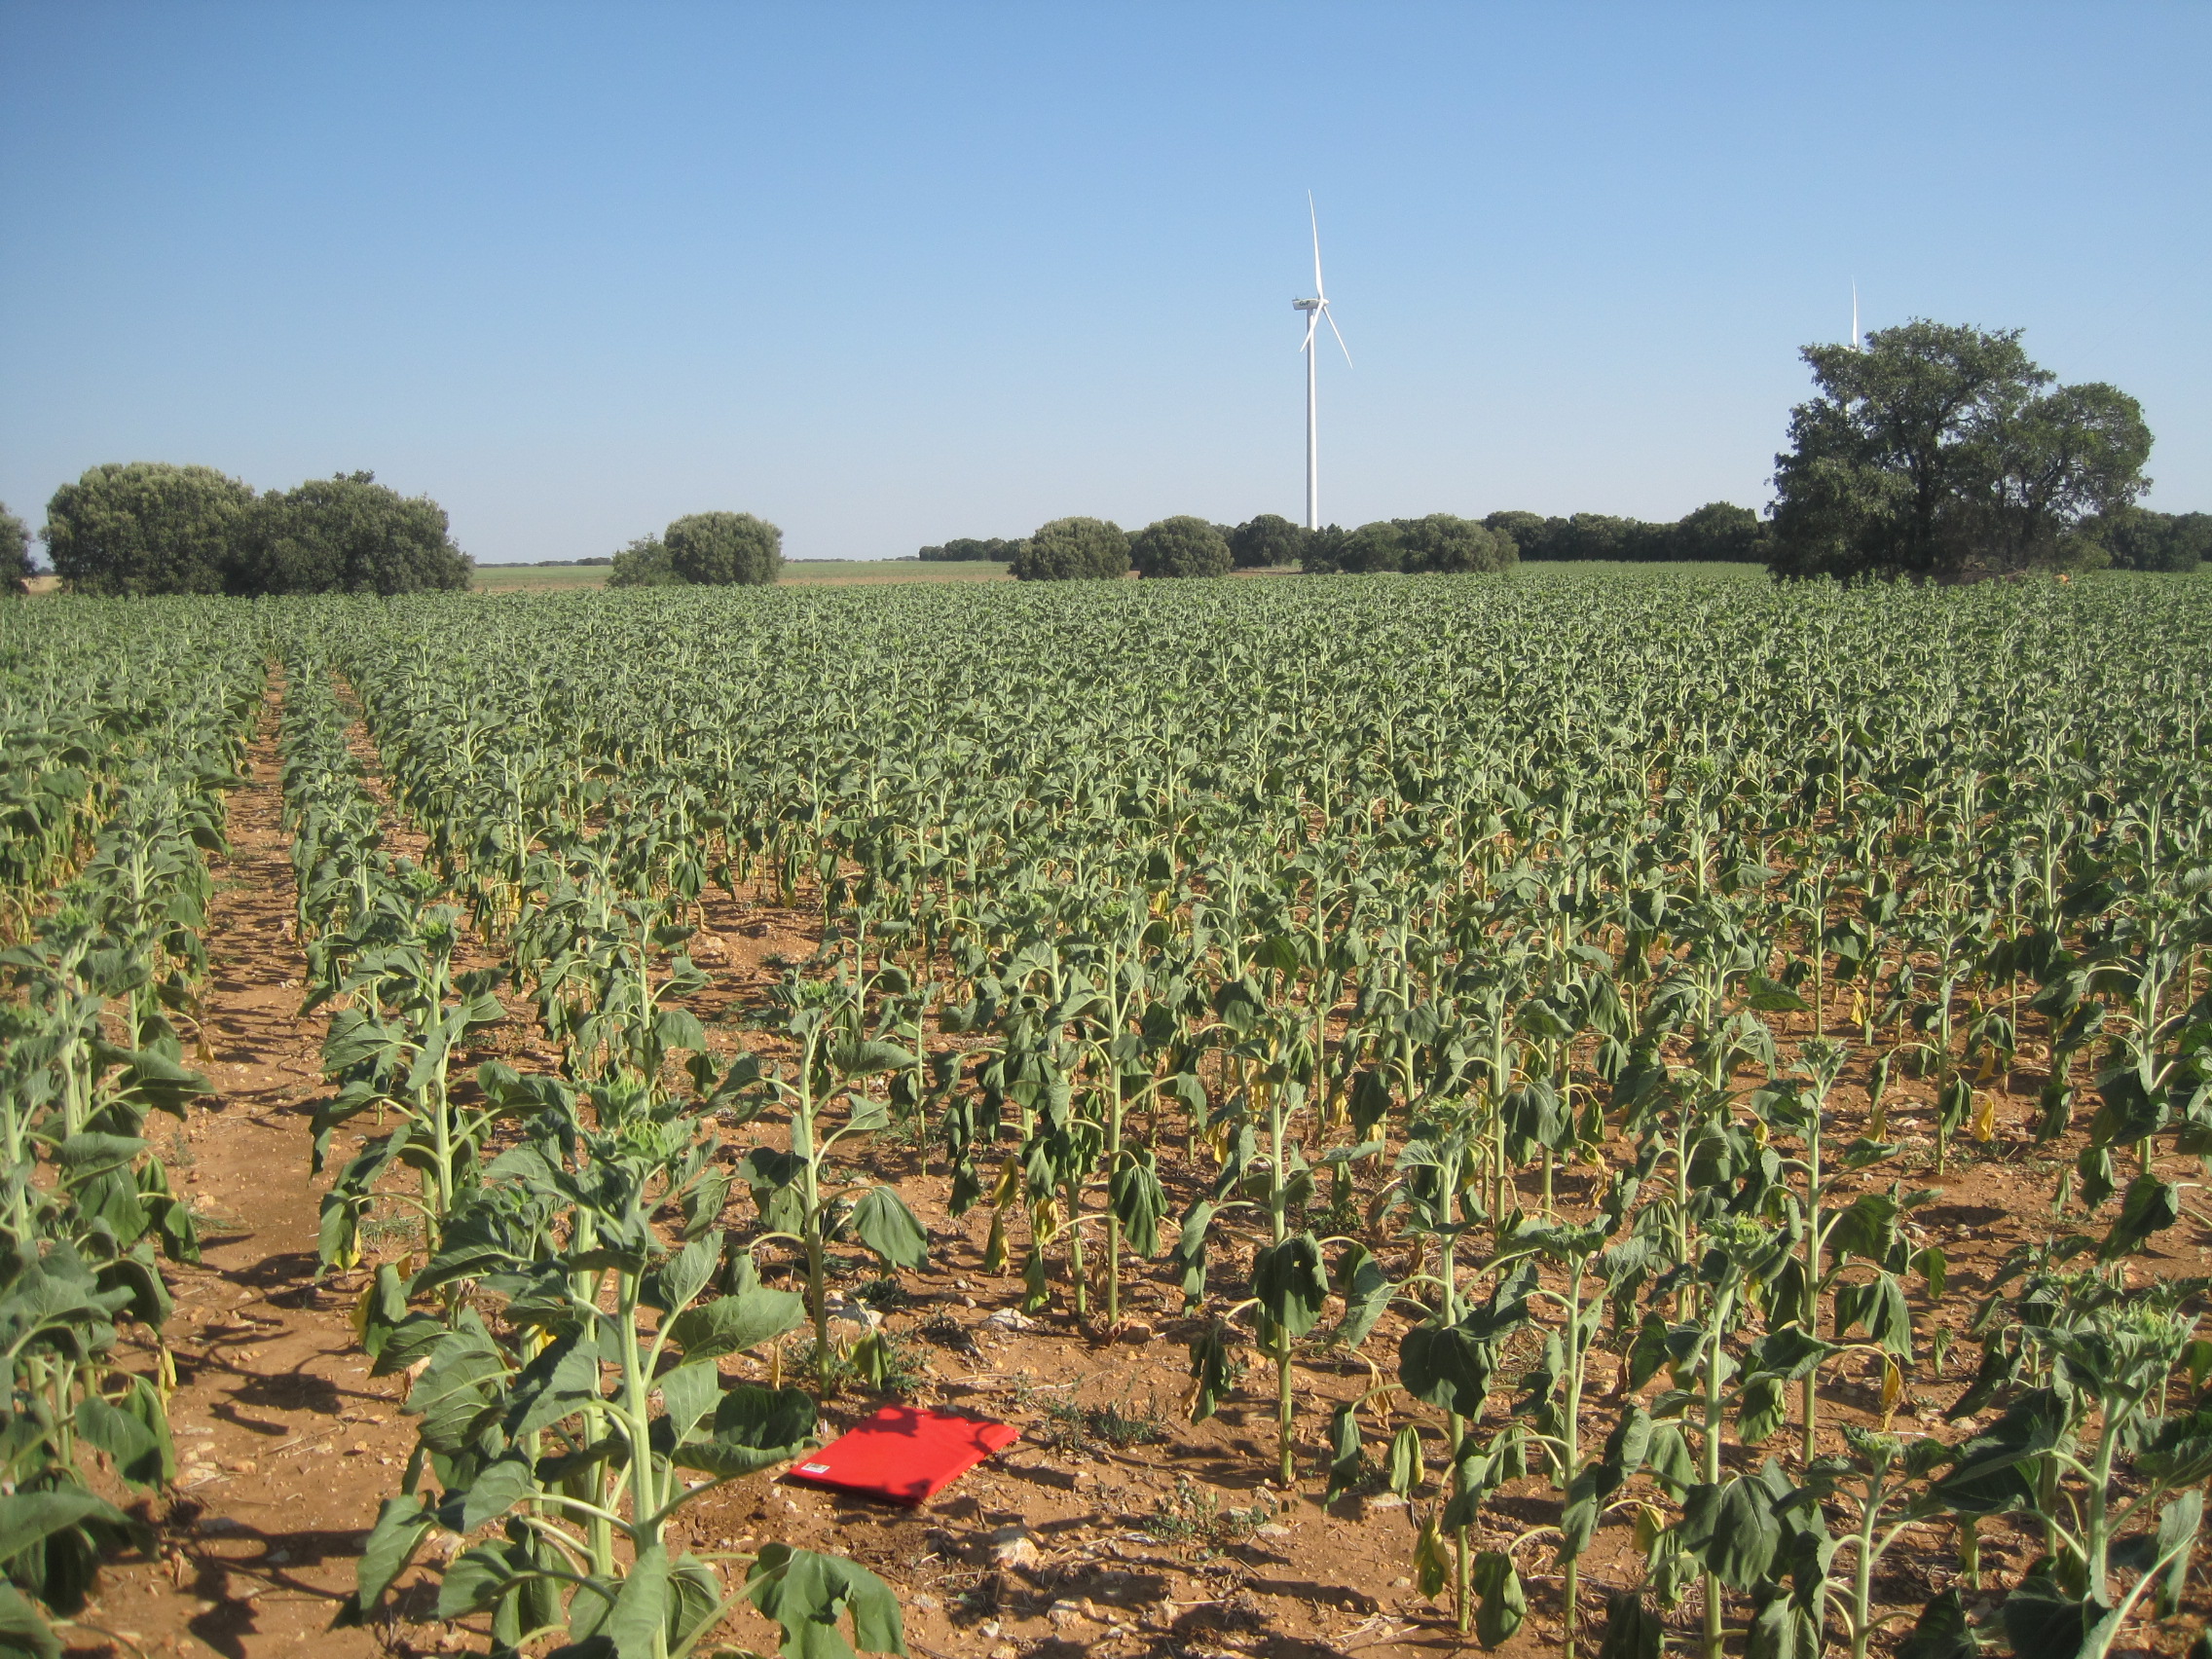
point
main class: Cropland
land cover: Sunflower
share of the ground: > 75 %
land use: Agriculture (excluding fallow land and kitchen gardens)
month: July
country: ES
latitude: 41.8631
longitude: -4.7331
